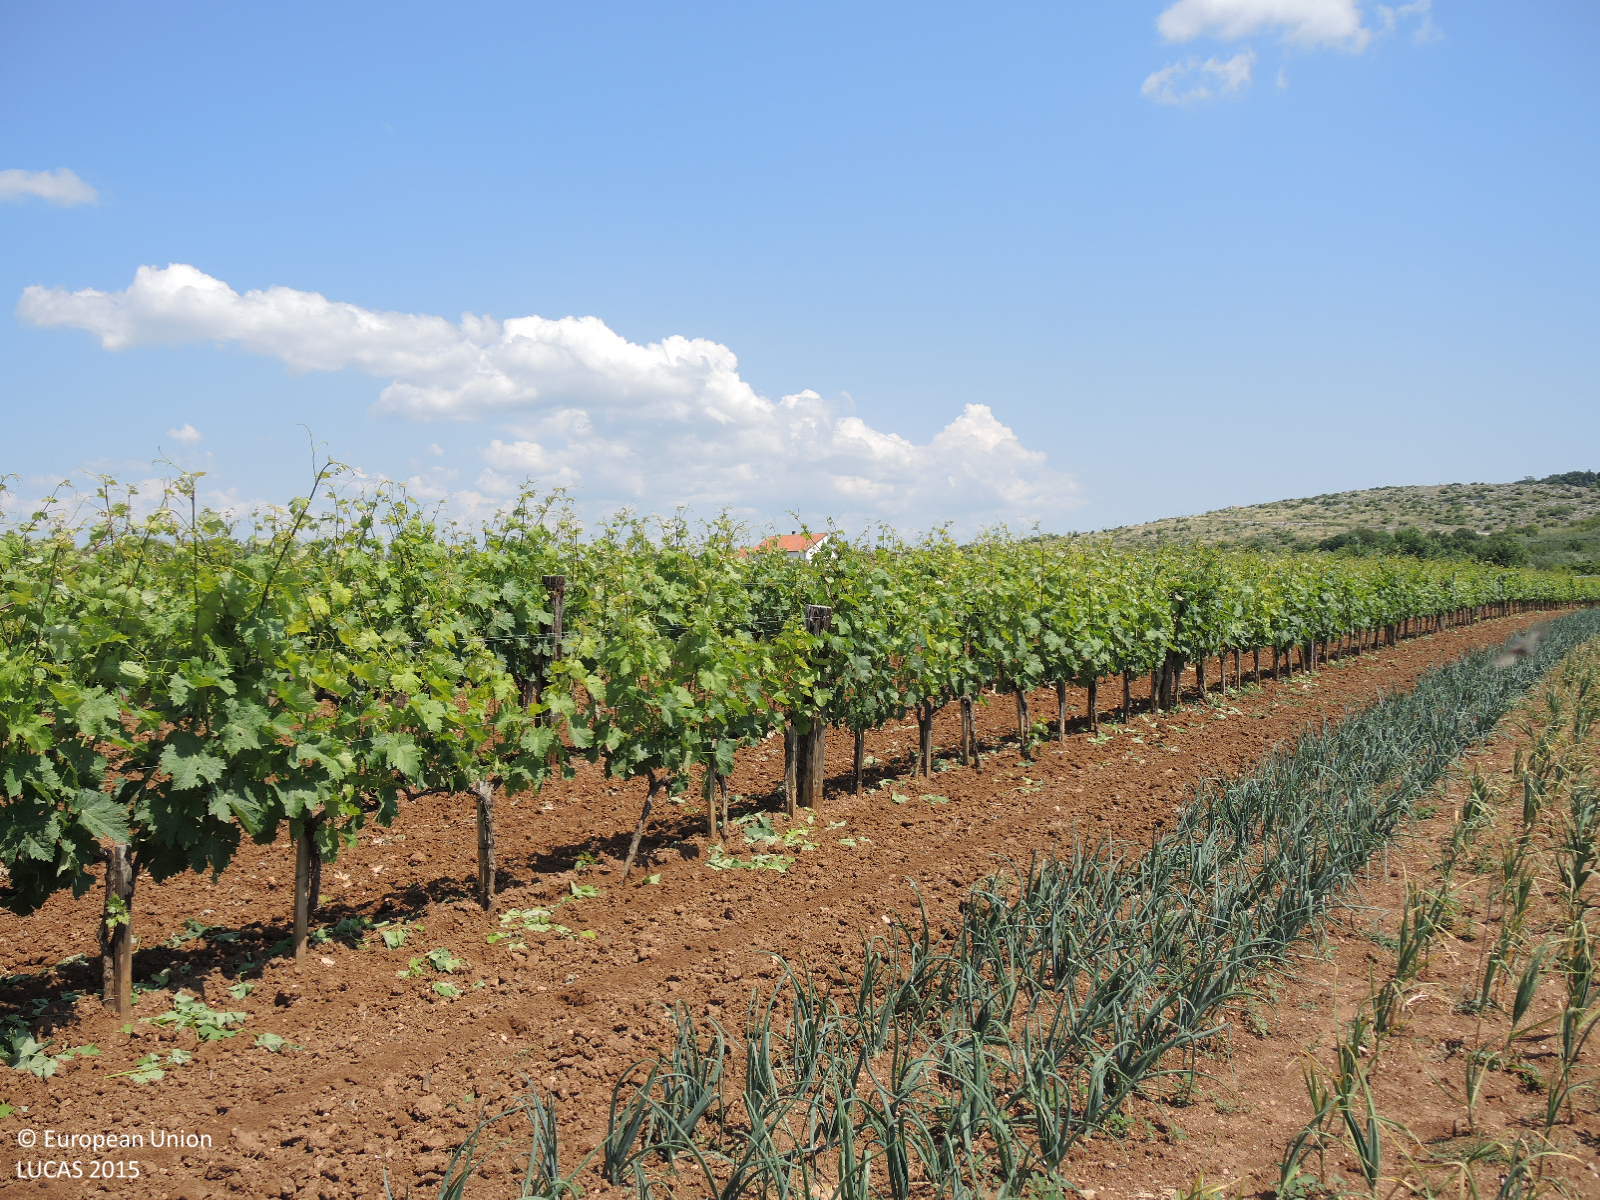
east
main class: Cropland
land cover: Other fresh vegetables
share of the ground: < 10 %
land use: Agriculture (excluding fallow land and kitchen gardens)
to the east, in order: Other fresh vegetables; Vineyards; Common wheat; Vineyards; Grassland without tree/shrub cover; Vineyards; Shrubland with sparse tree cover; Olive groves; Grassland without tree/shrub cover; Olive groves; Grassland without tree/shrub cover; Artificial constructions in urban areas; Cherry fruit; Shrubland with sparse tree cover
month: May
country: HR
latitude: 44.0782
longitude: 15.4989
